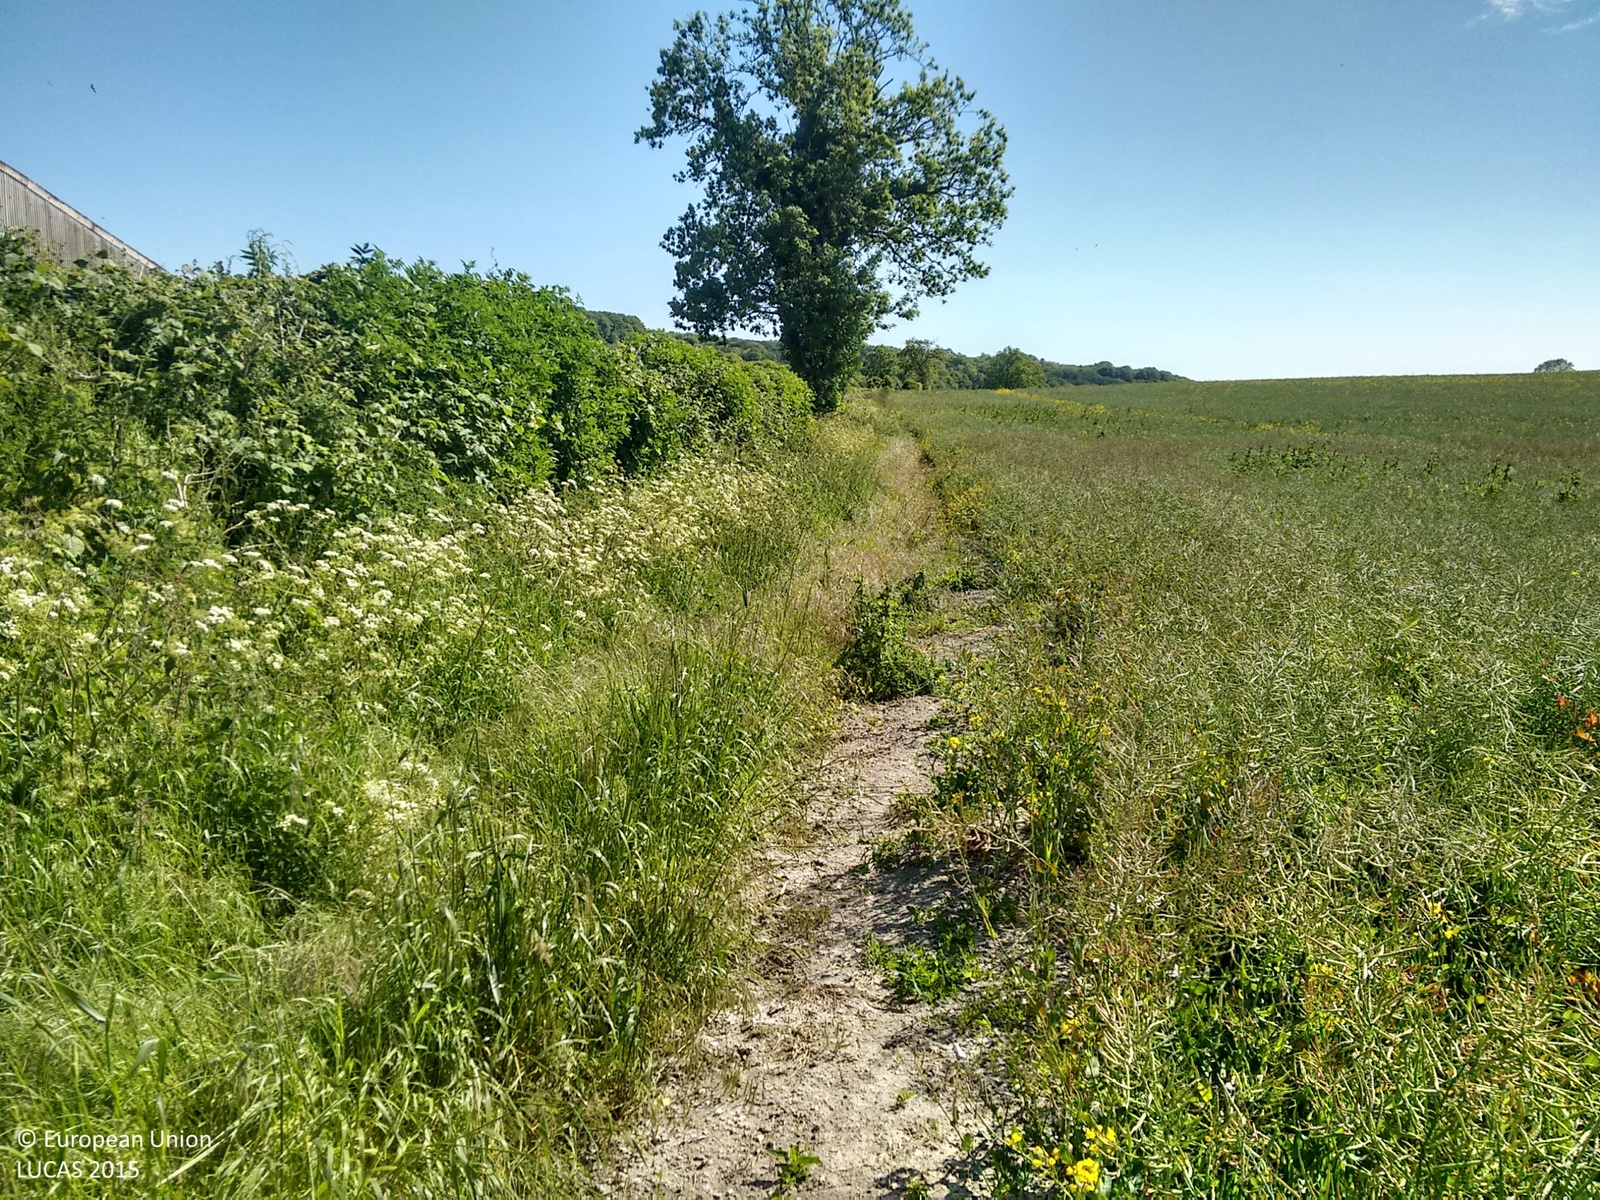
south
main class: Cropland
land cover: Rape and turnip rape
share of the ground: > 75 %
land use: Agriculture (excluding fallow land and kitchen gardens)
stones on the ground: 10 - 25 %
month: June
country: GB
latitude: 51.2574
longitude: -2.1694
